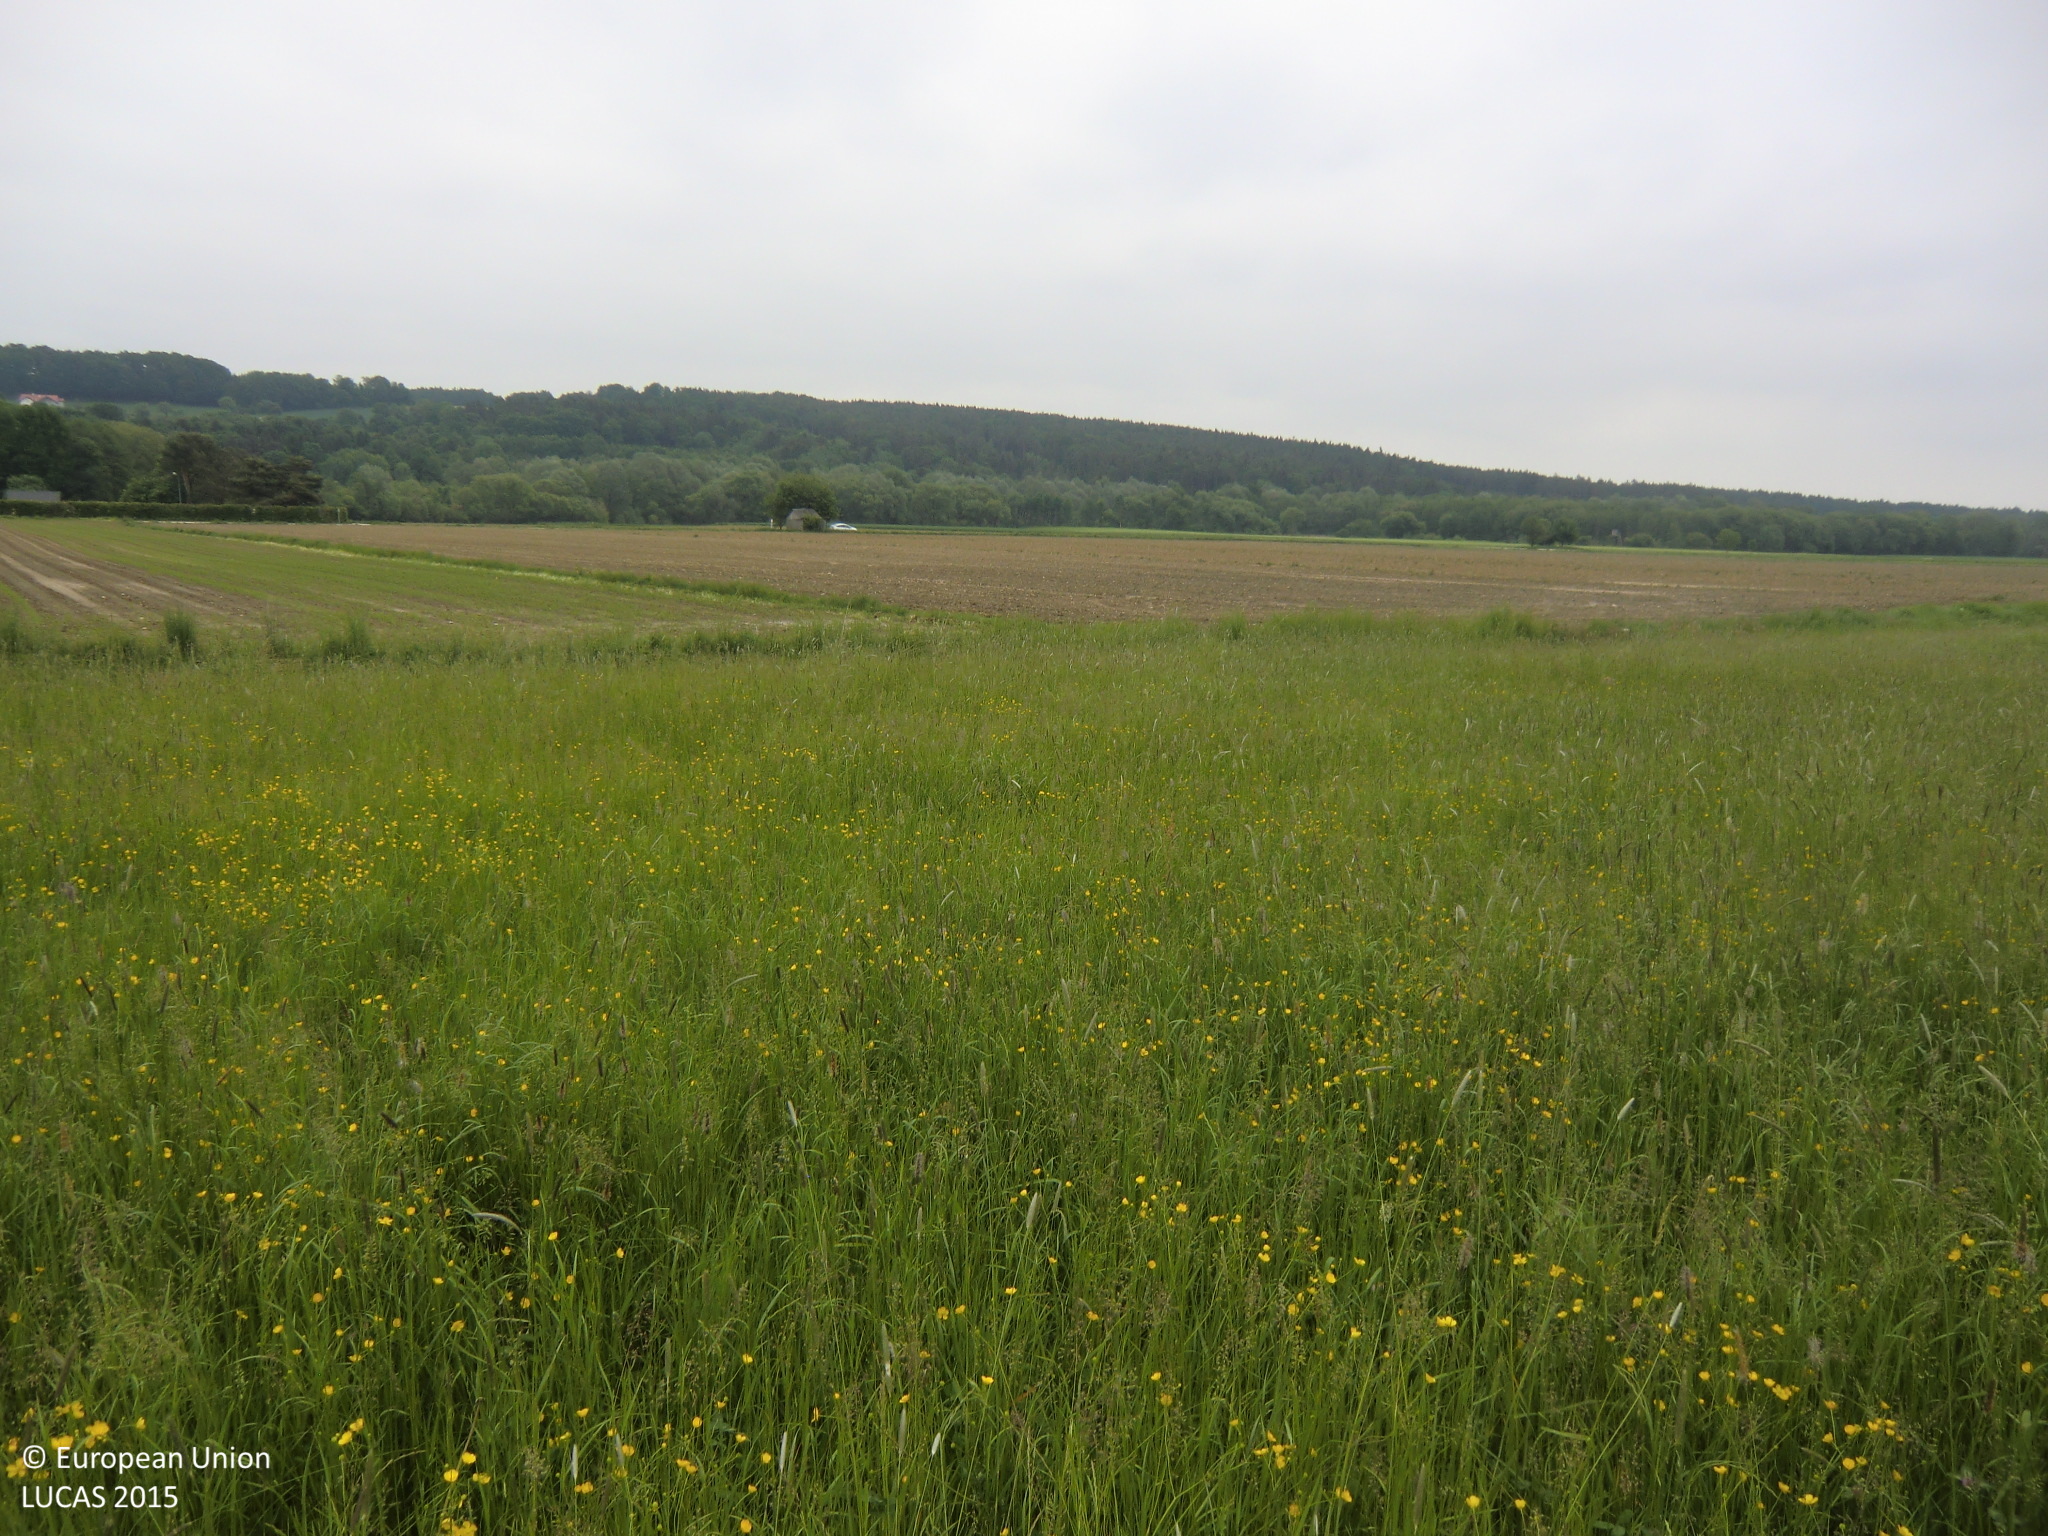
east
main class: Grassland
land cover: Grassland without tree/shrub cover
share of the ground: > 75 %
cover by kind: herbaceous plants 100 %
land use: Agriculture (excluding fallow land and kitchen gardens)
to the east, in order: Grassland without tree/shrub cover; Ditches and canals; Grass margins; Maize; Other fibre and oleaginous crops; Grass margins; Tracks
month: May
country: AT
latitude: 47.3549
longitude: 16.0256
